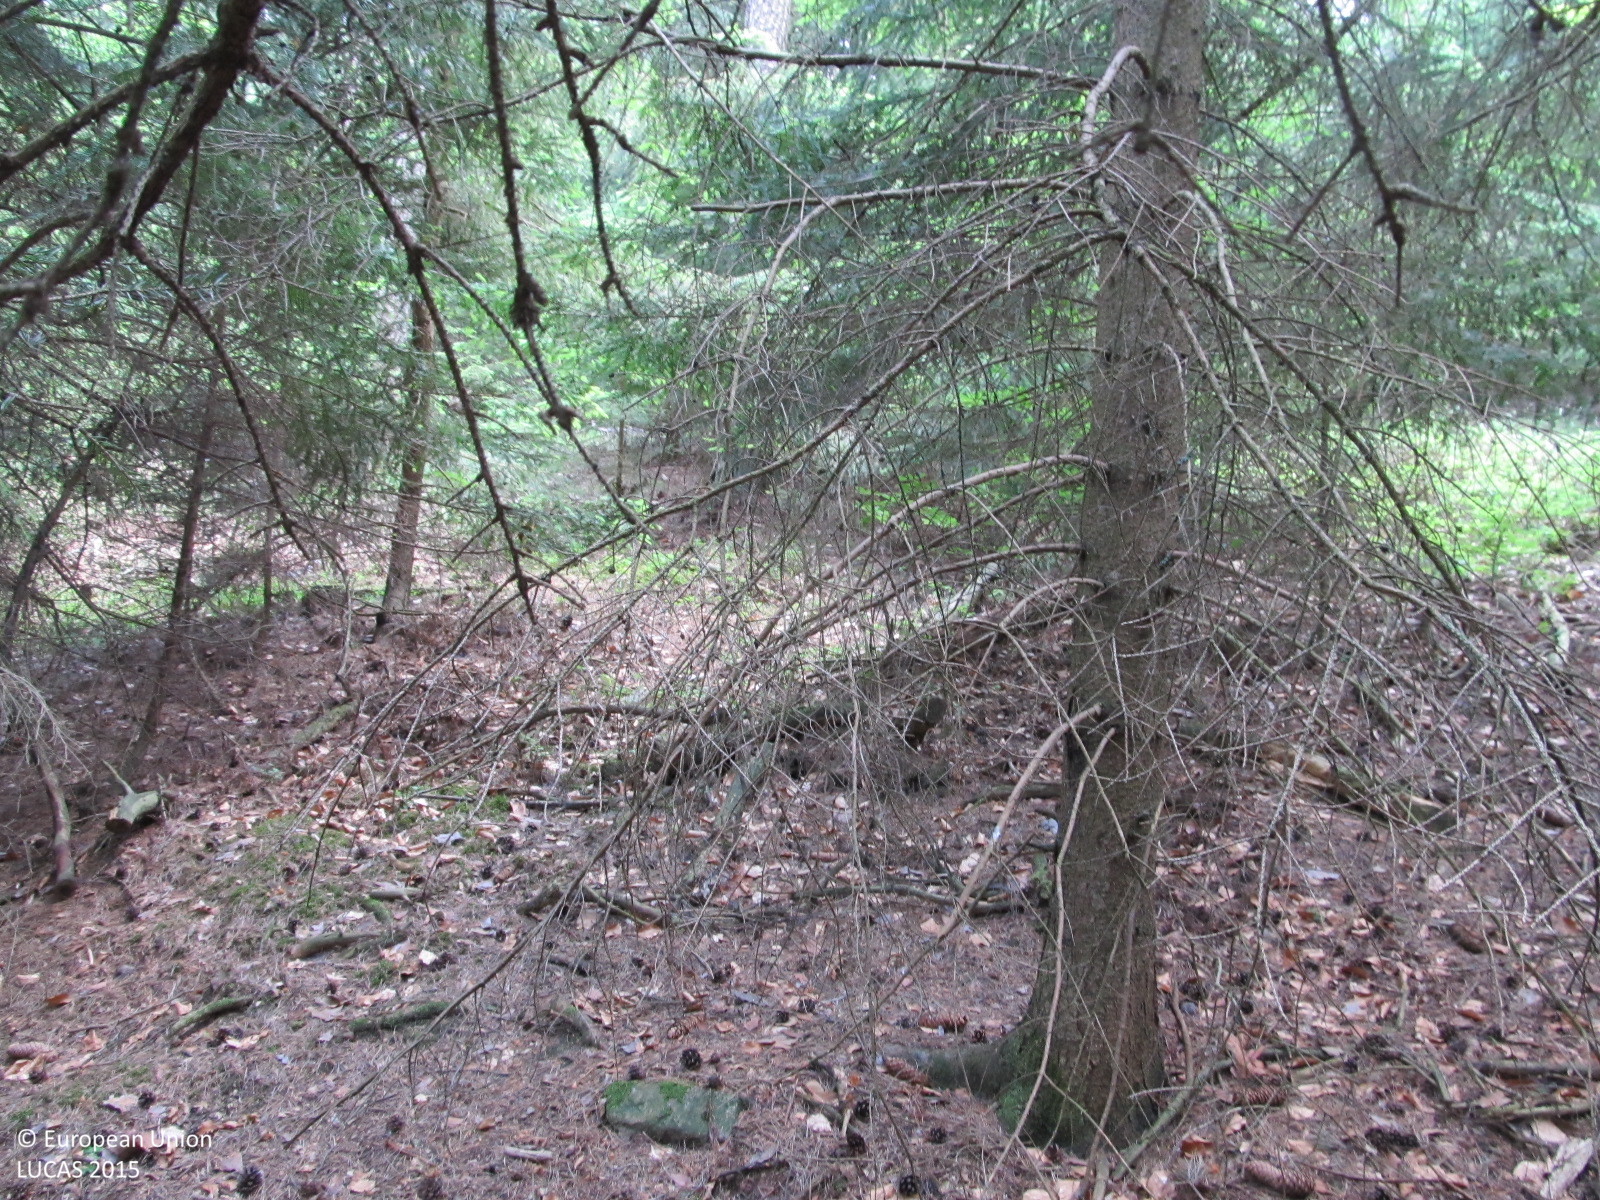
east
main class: Woodland
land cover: Spruce dominated coniferous woodland
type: hemiboreal forest and nemoral coniferous forest and mixed broadleaved-coniferous forest
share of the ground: > 75 %
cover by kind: coniferous forest trees 85 %, unconsolidated bare surface 10 %, broadleaved forest trees 5 %
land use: Forestry
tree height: > 5 m
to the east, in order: Spruce dominated coniferous woodland; Tracks; Spruce dominated mixed woodland; Tracks; Spruce dominated mixed woodland; Tracks; Spruce dominated mixed woodland; Tracks; Spruce dominated coniferous woodland; Grass margins; Clovers
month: June
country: AT
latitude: 48.4301
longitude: 15.4762
